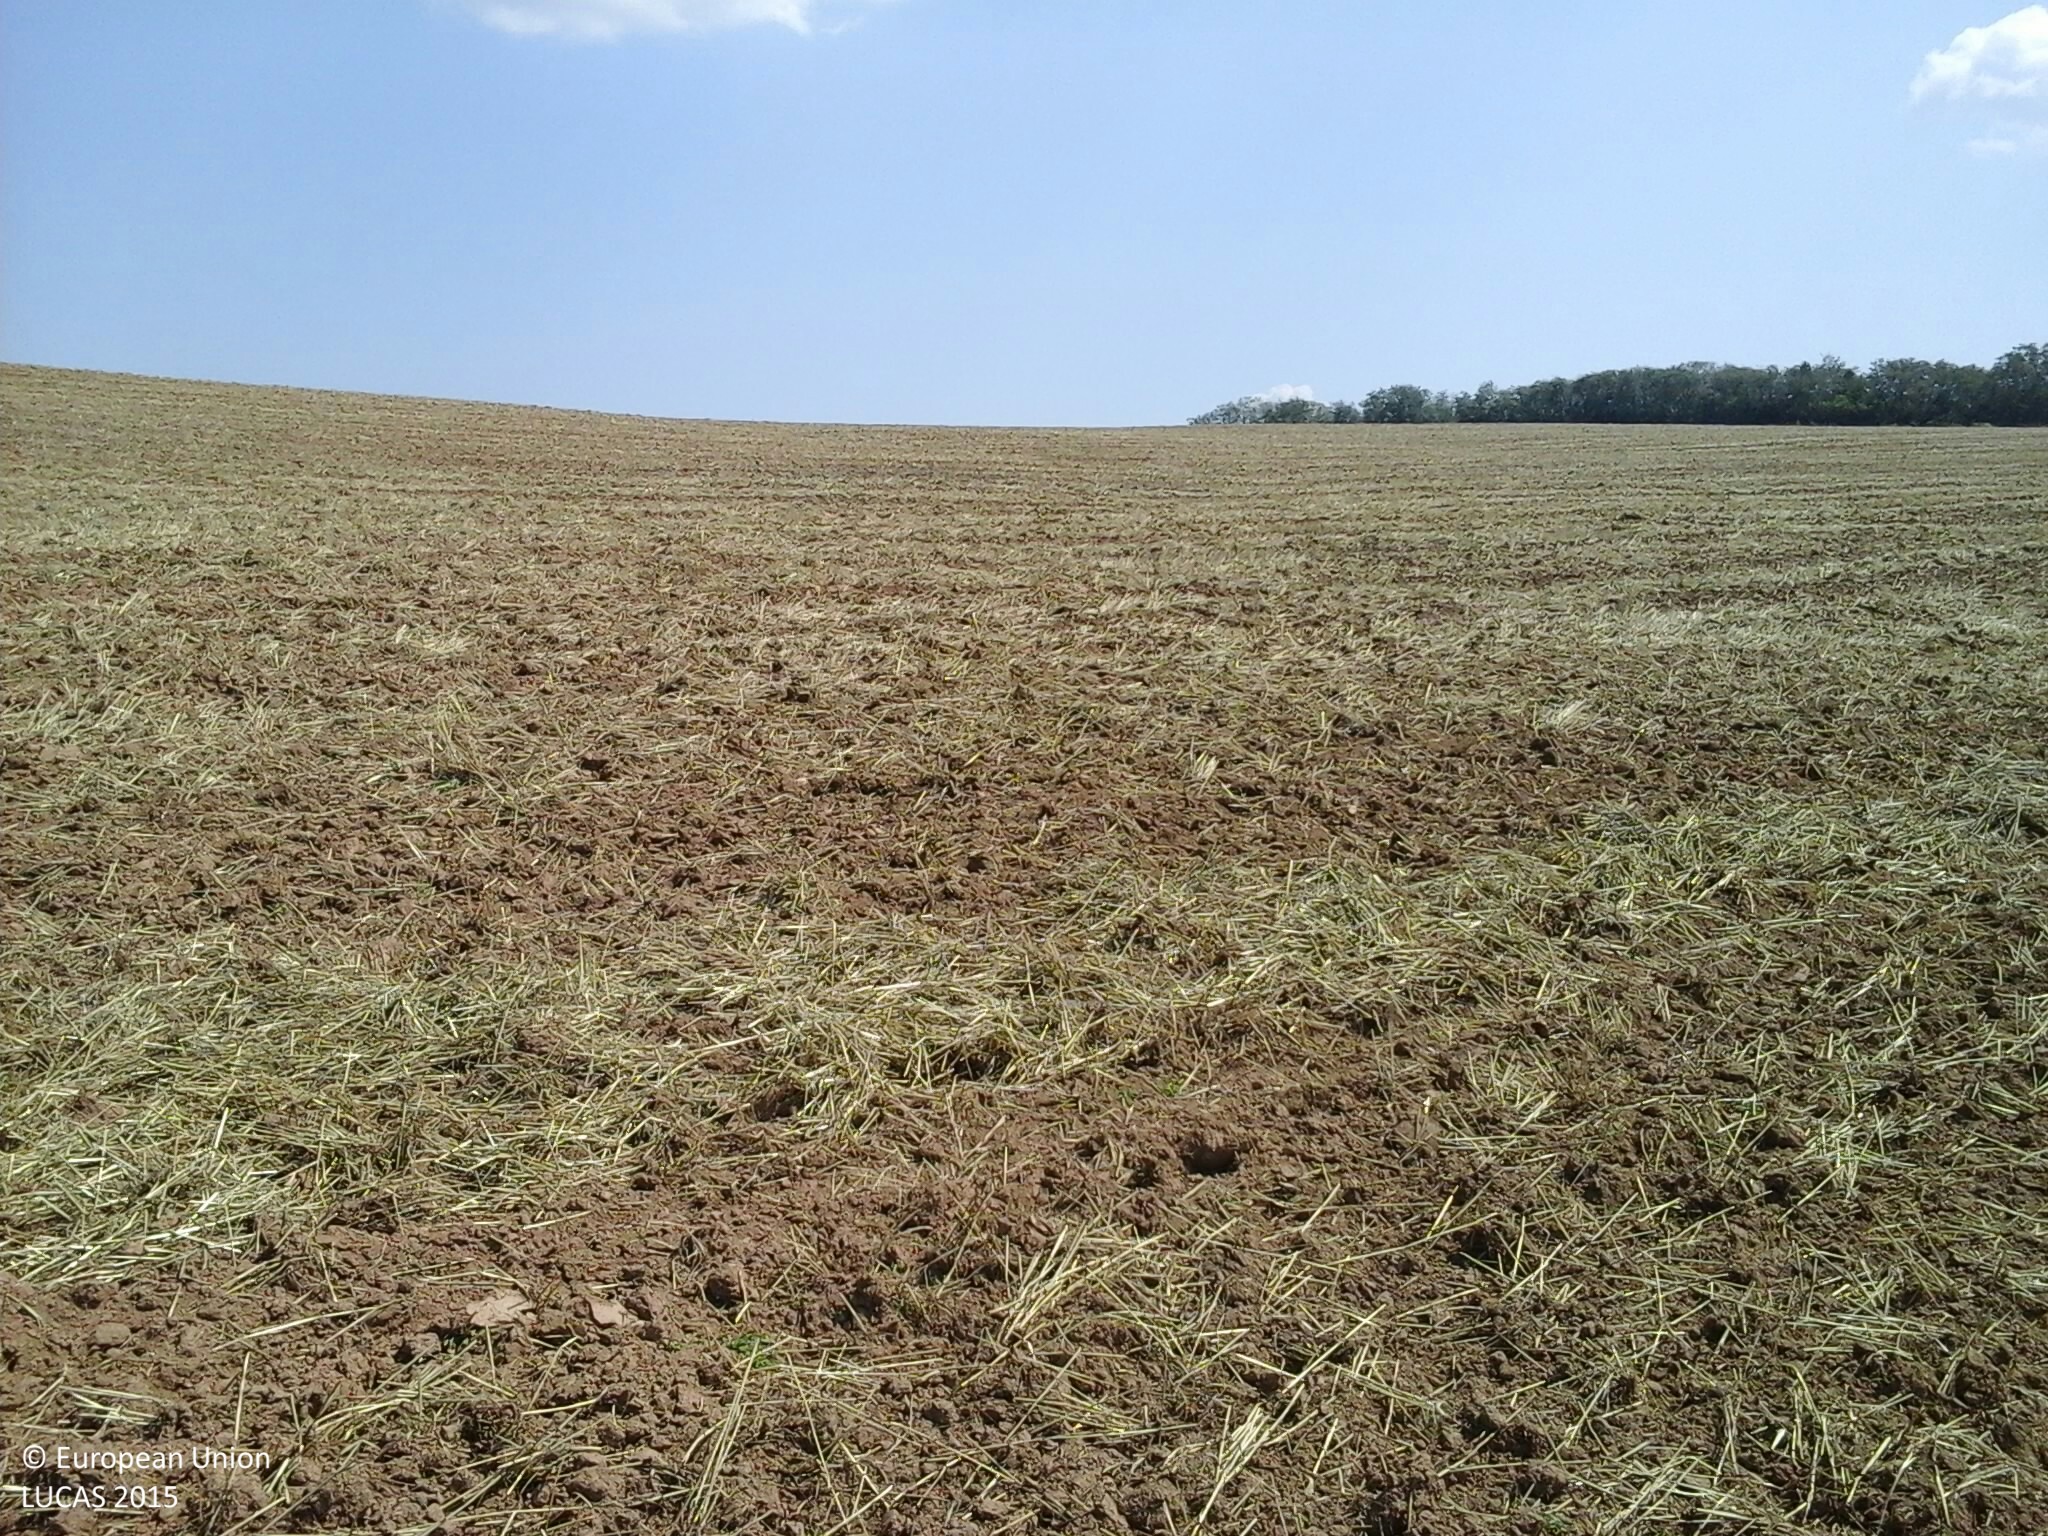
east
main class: Cropland
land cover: Common wheat
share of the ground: < 10 %
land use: Agriculture (excluding fallow land and kitchen gardens)
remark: Harvested field
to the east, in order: Common wheat
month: August
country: HU
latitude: 48.4167
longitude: 20.8068
